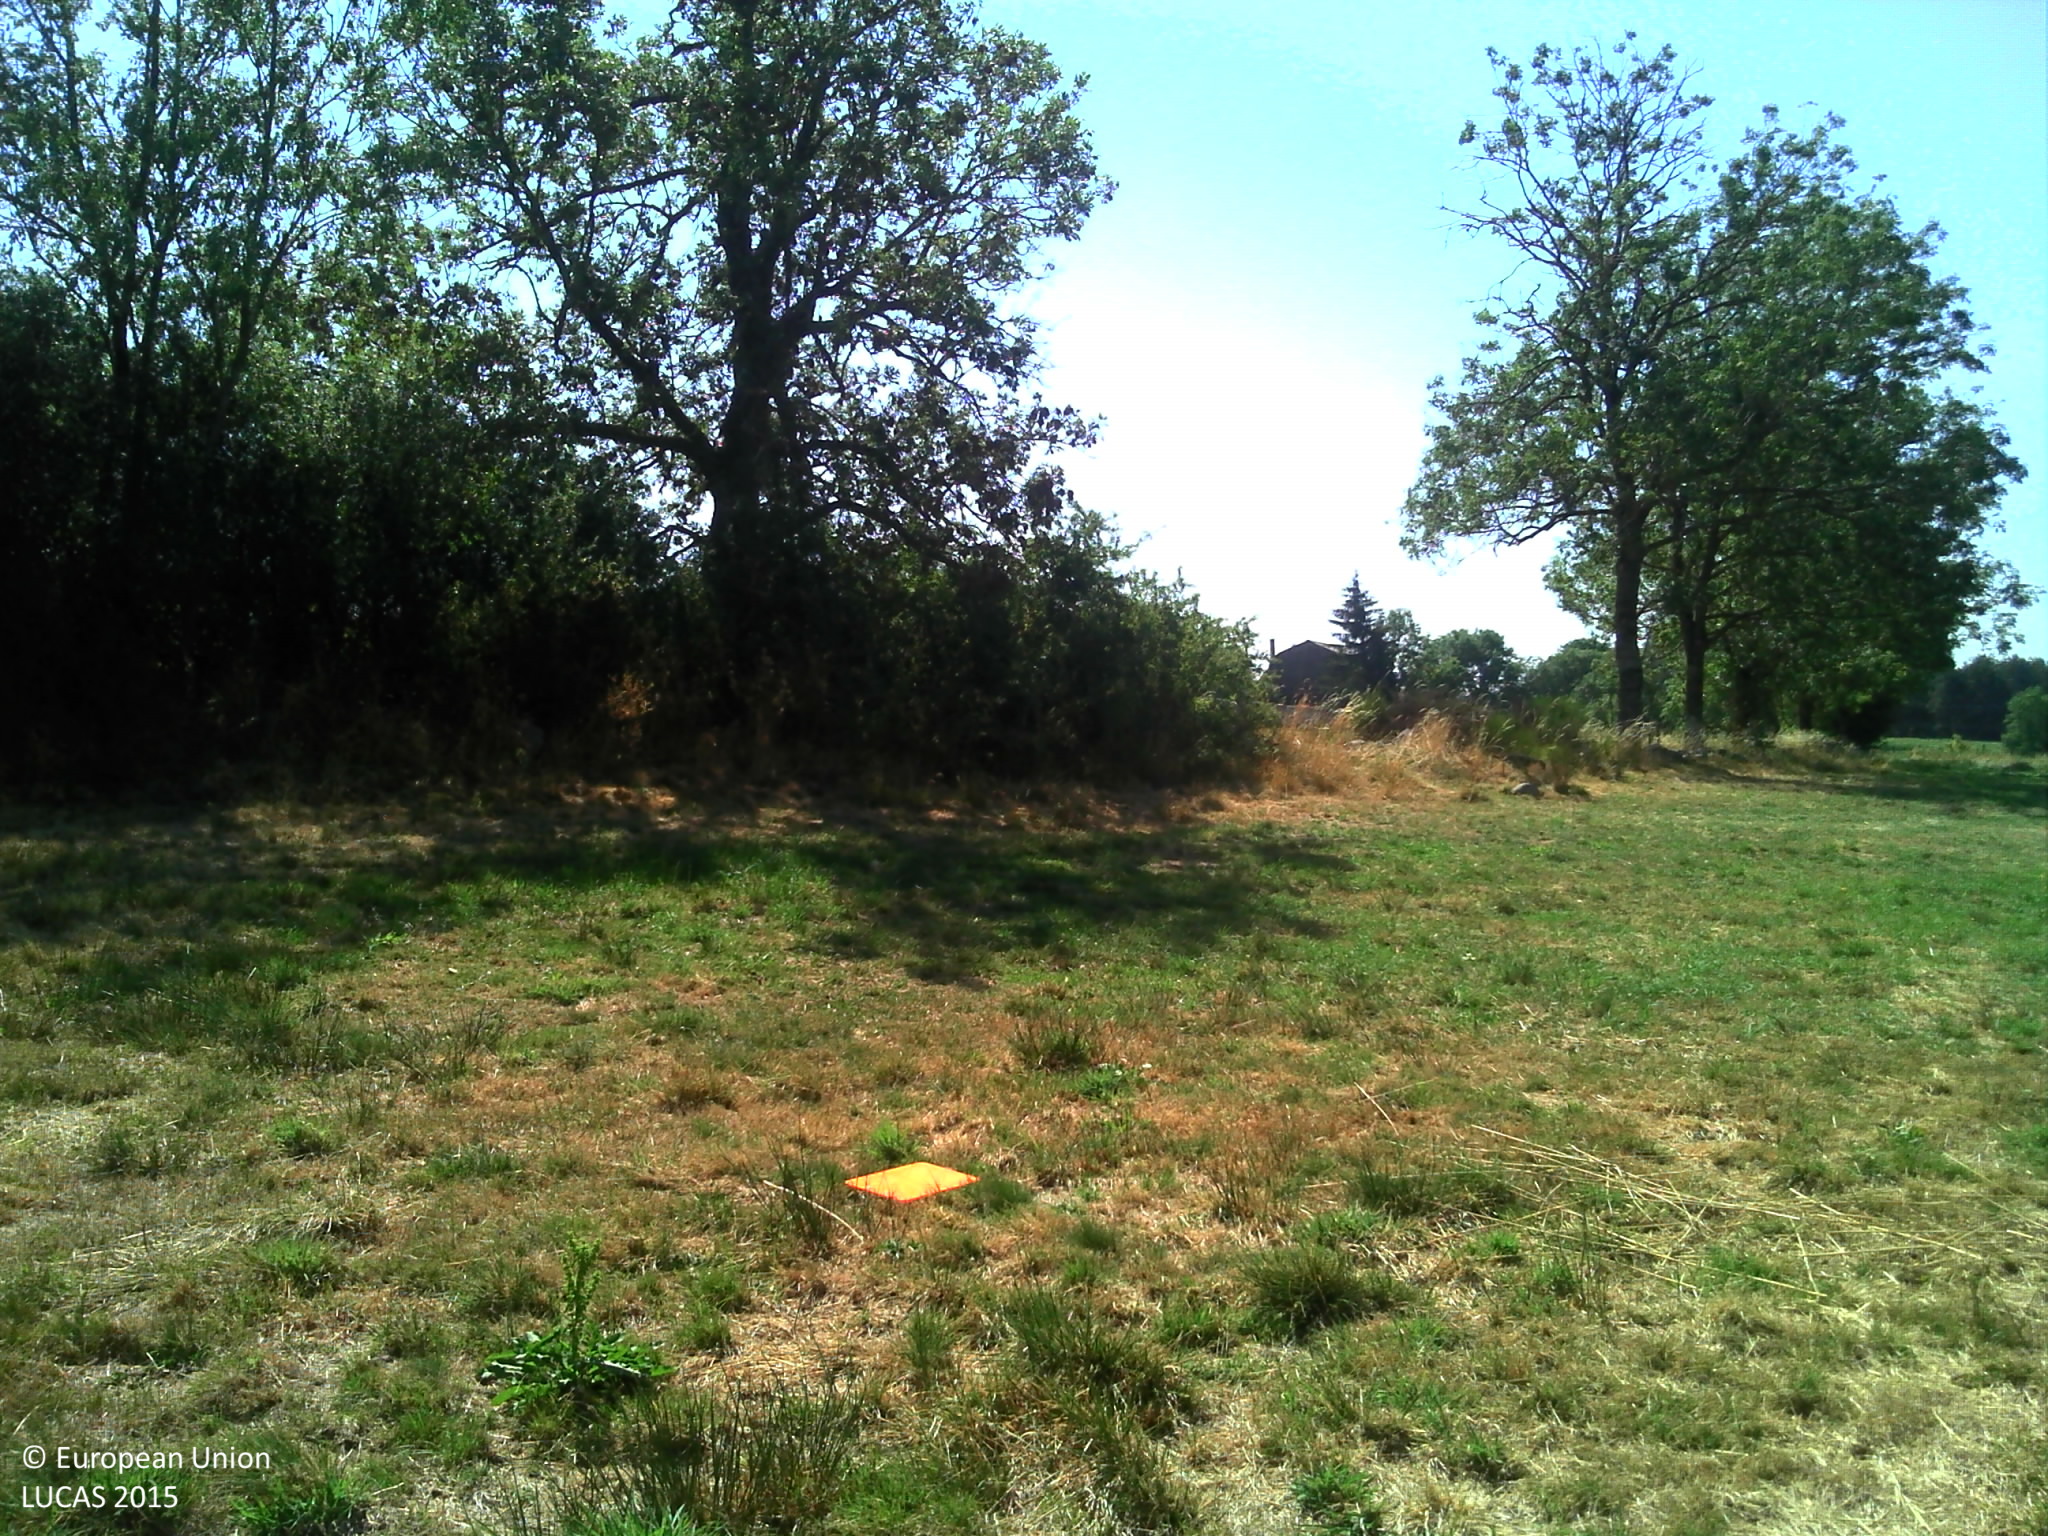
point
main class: Grassland
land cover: Grassland without tree/shrub cover
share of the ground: > 75 %
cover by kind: herbaceous plants 100 %
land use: Agriculture (excluding fallow land and kitchen gardens)
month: August
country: FR
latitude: 45.2139
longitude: 3.8023
